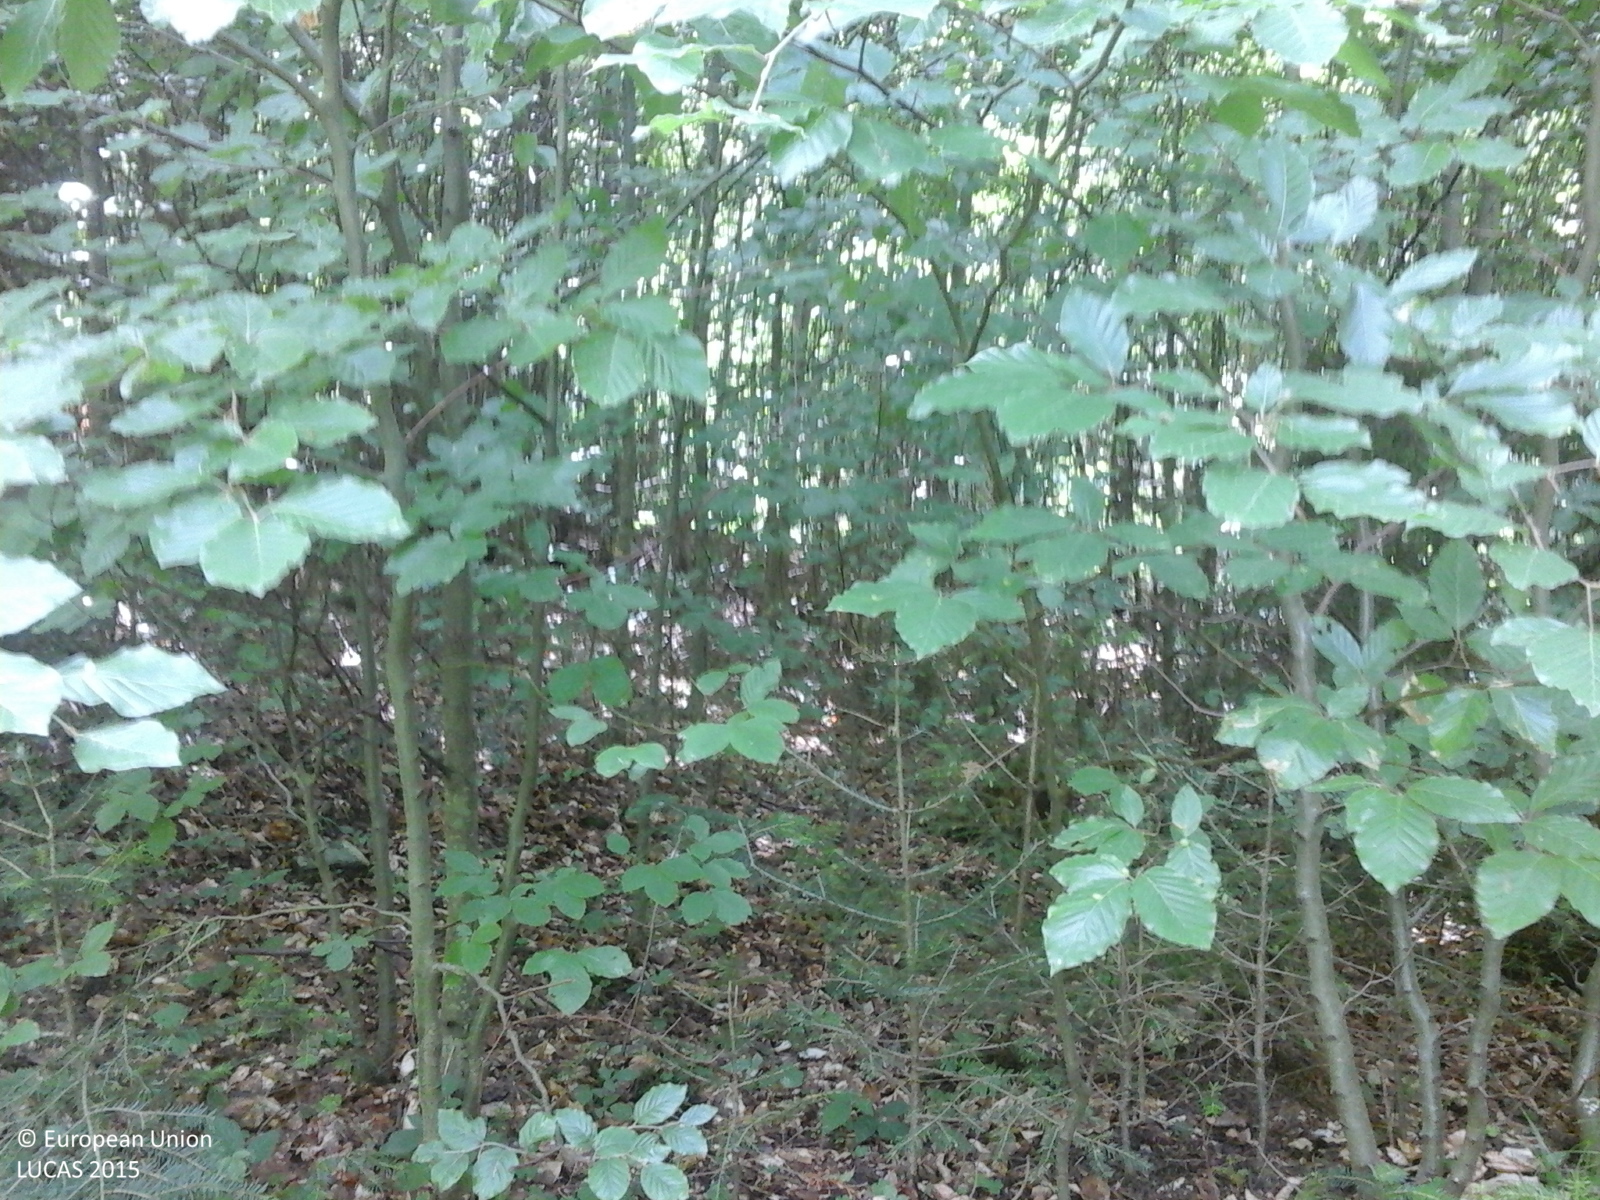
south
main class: Woodland
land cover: Other mixed woodland
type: beech forest
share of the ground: > 75 %
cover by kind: broadleaved forest trees 75 %, coniferous forest trees 25 %
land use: Forestry
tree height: > 5 m
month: June
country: RO
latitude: 47.6906
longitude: 25.7246
